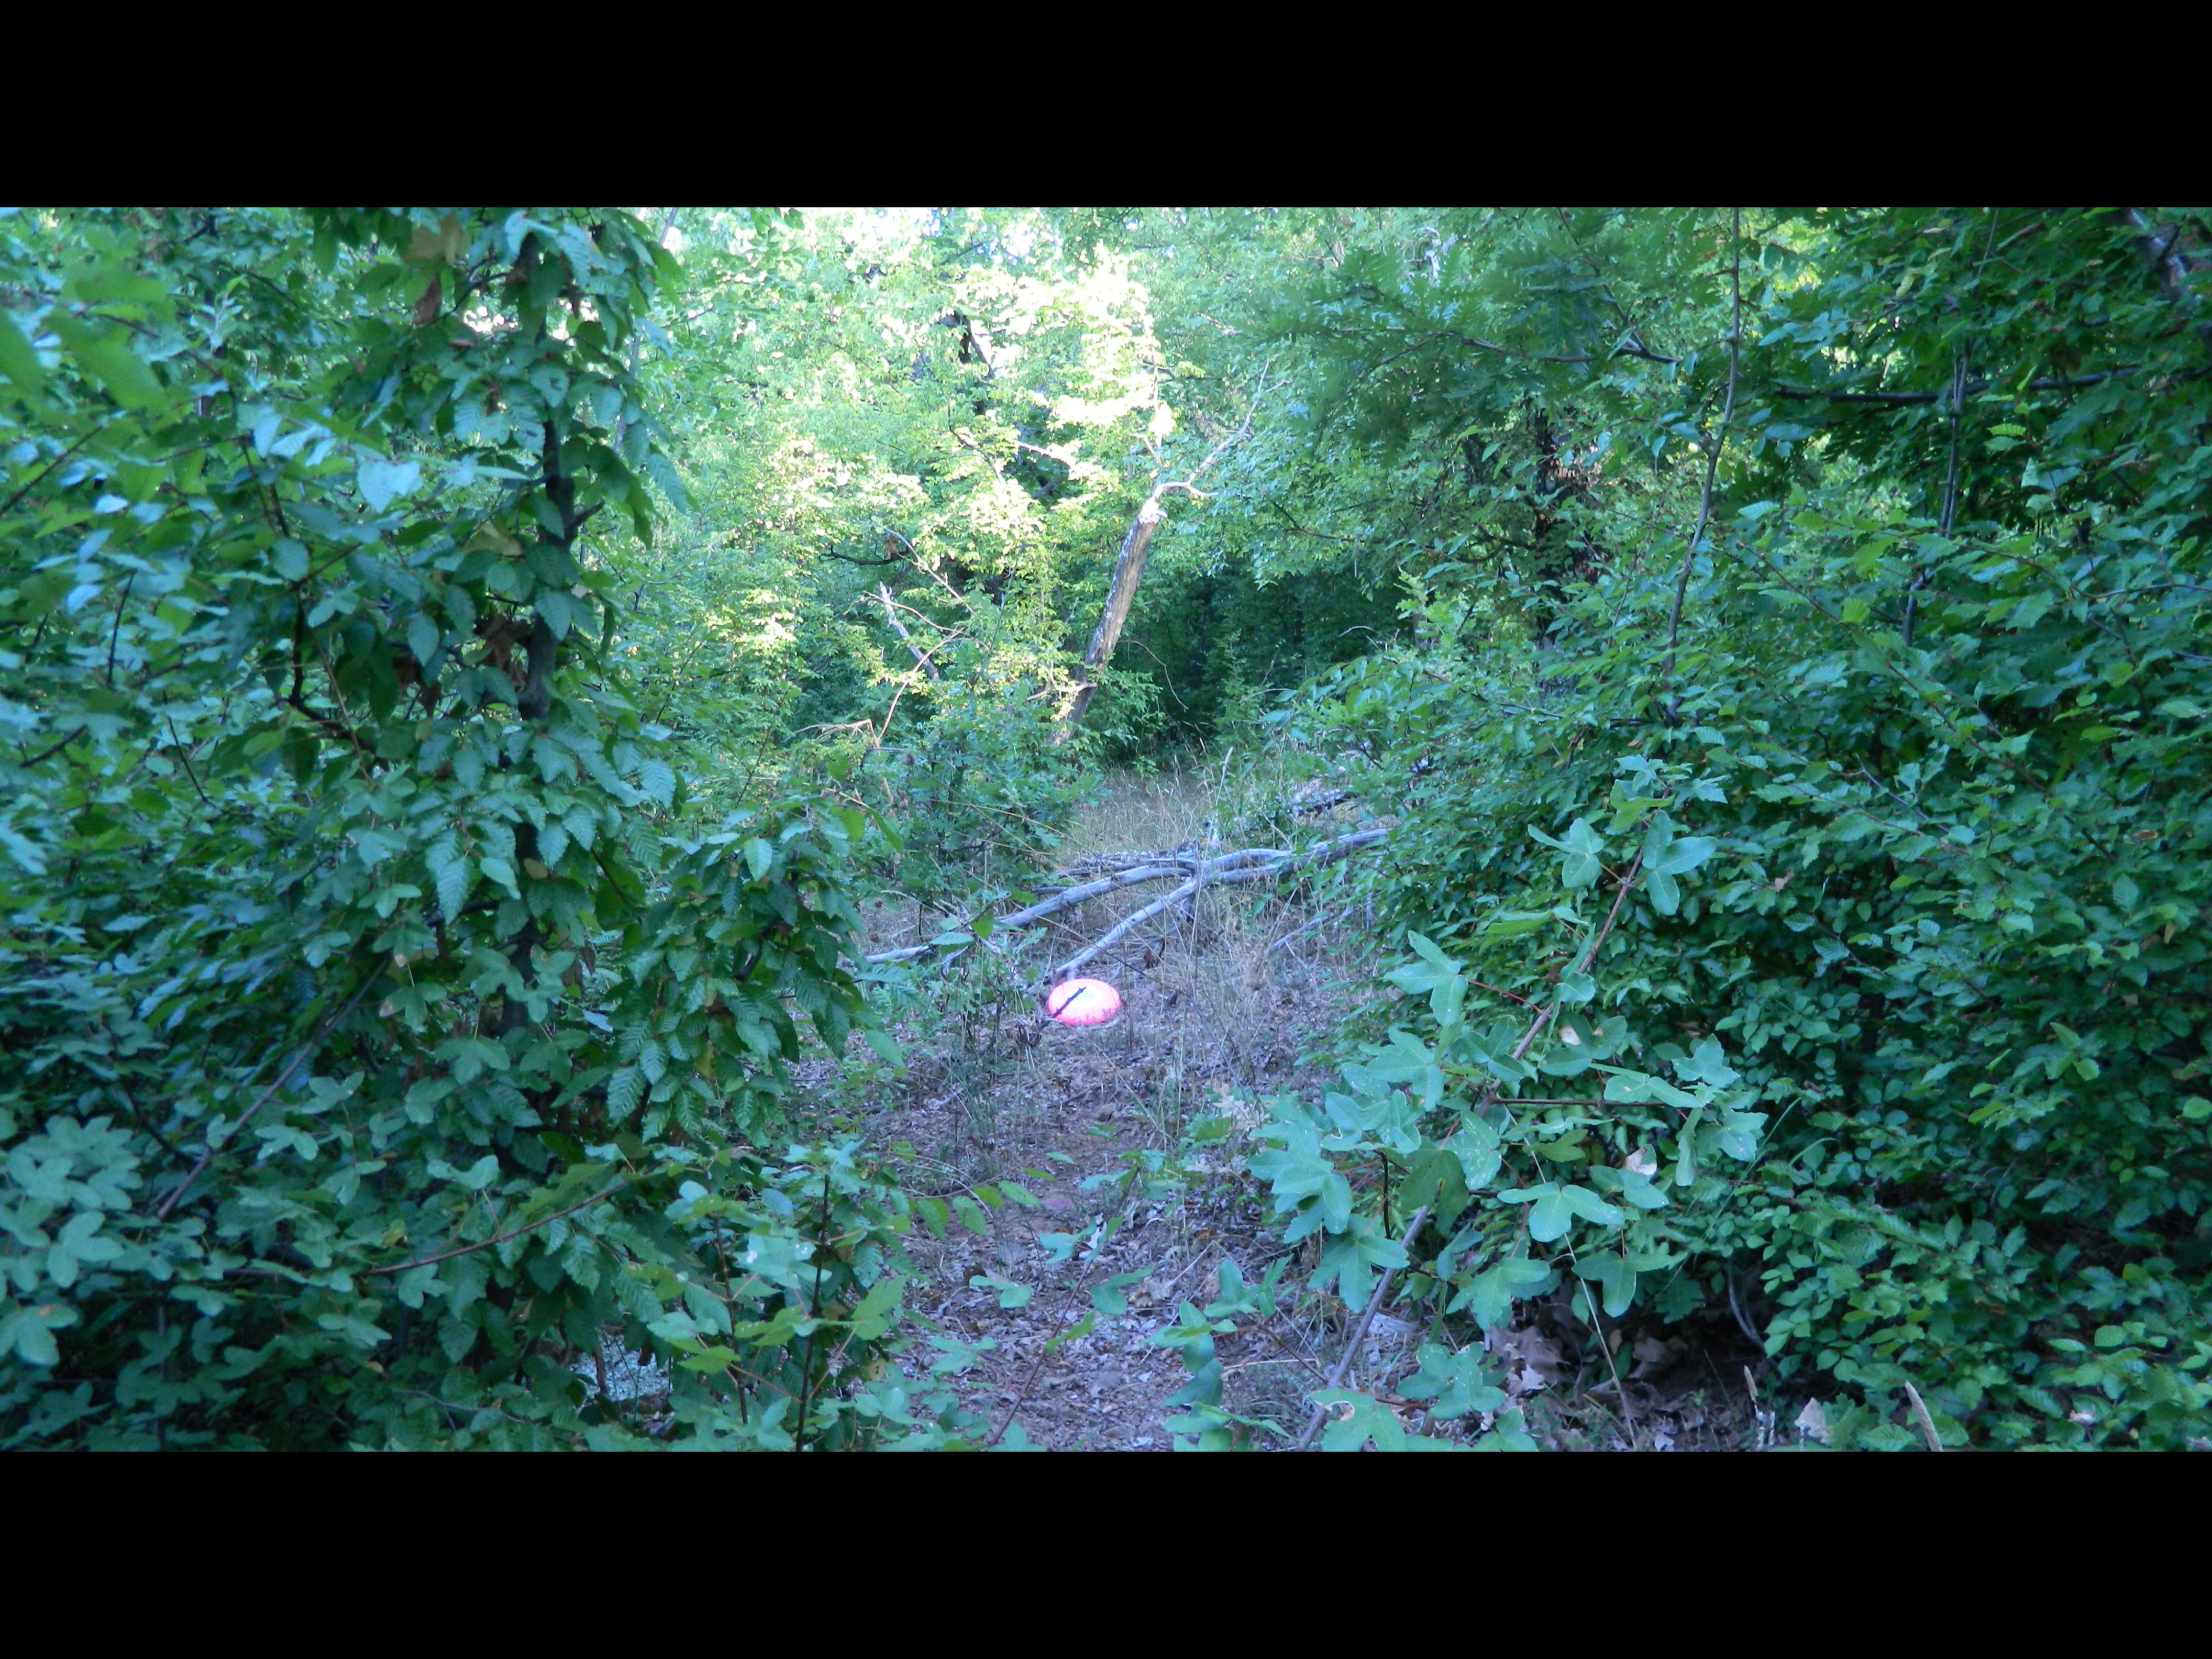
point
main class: Woodland
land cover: Broadleaved woodland
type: mesophytic deciduous forest
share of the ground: > 75 %
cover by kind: broadleaved forest trees 70 %, shrubs 15 %, unconsolidated bare surface 10 %, herbaceous plants 5 %
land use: Forestry
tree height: > 5 m
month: August
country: BG
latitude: 41.6490
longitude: 25.8805
